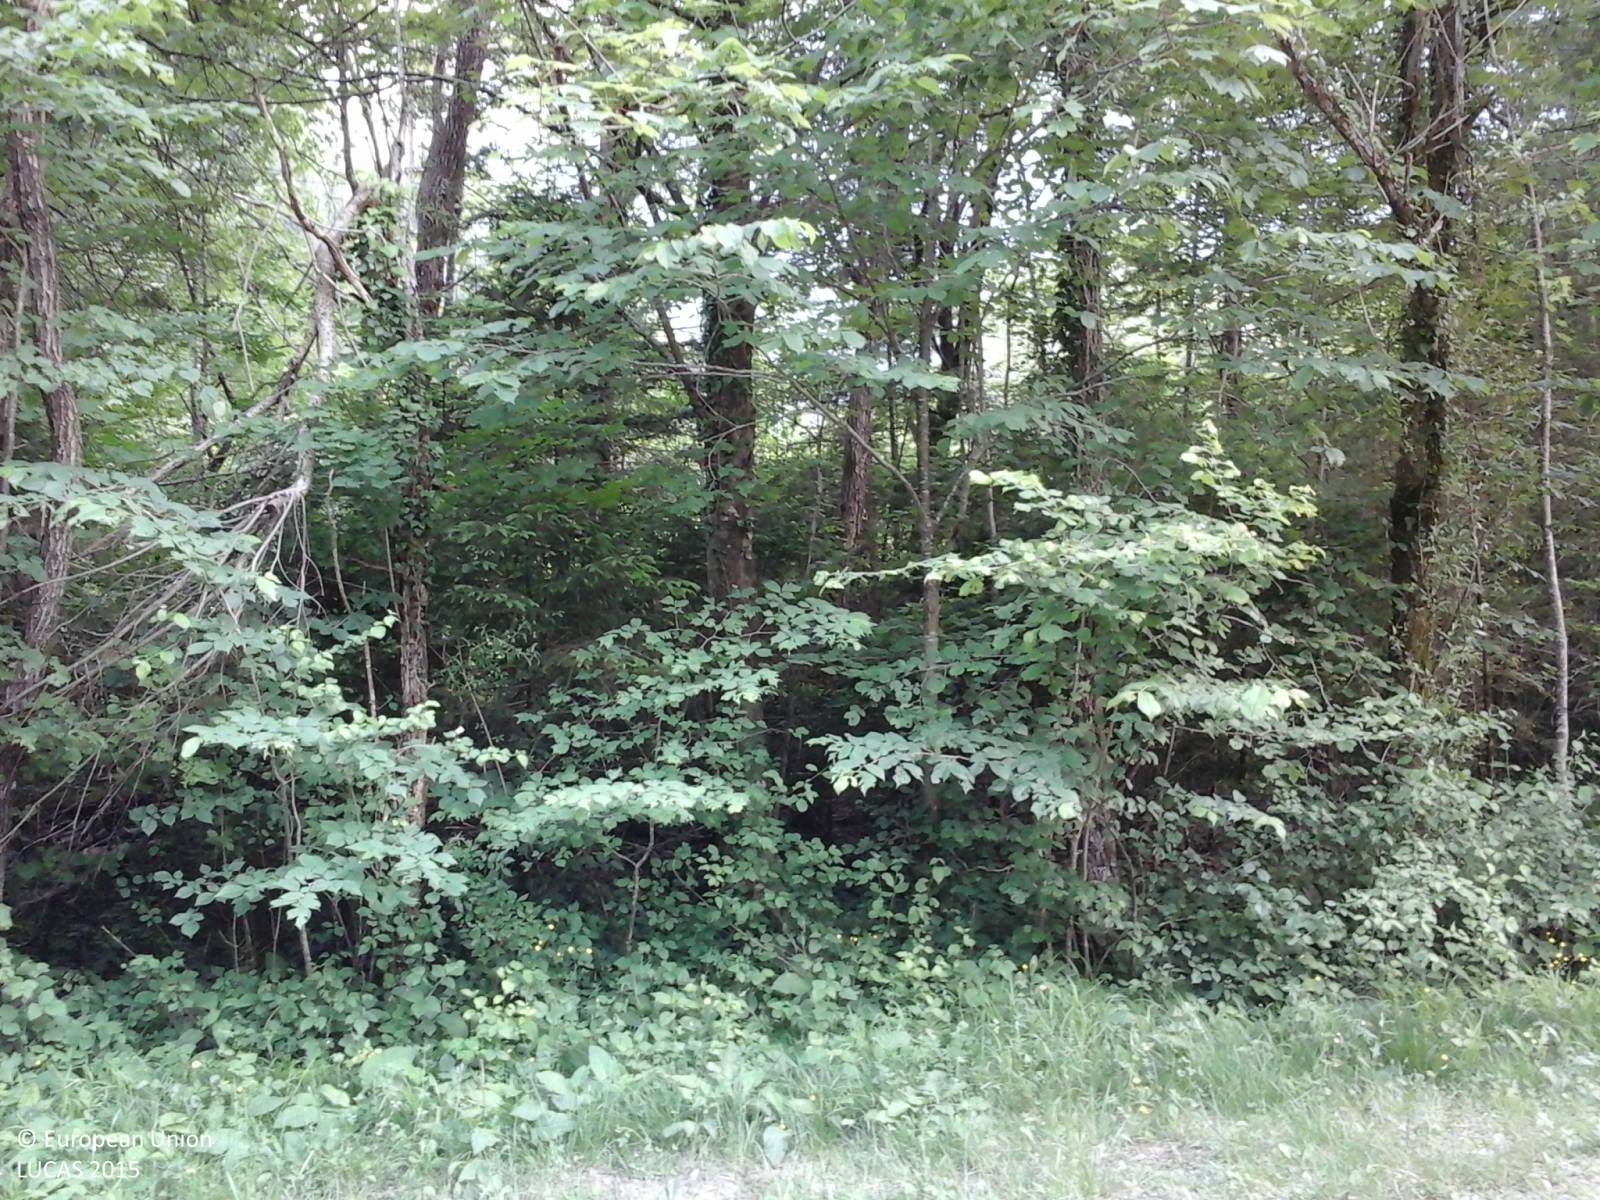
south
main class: Woodland
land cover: Other mixed woodland
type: mesophytic deciduous forest
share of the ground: > 75 %
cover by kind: broadleaved forest trees 60 %, coniferous forest trees 30 %, shrubs 10 %
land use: Forestry
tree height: > 5 m
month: June
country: IT
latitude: 46.3625
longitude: 13.0253
